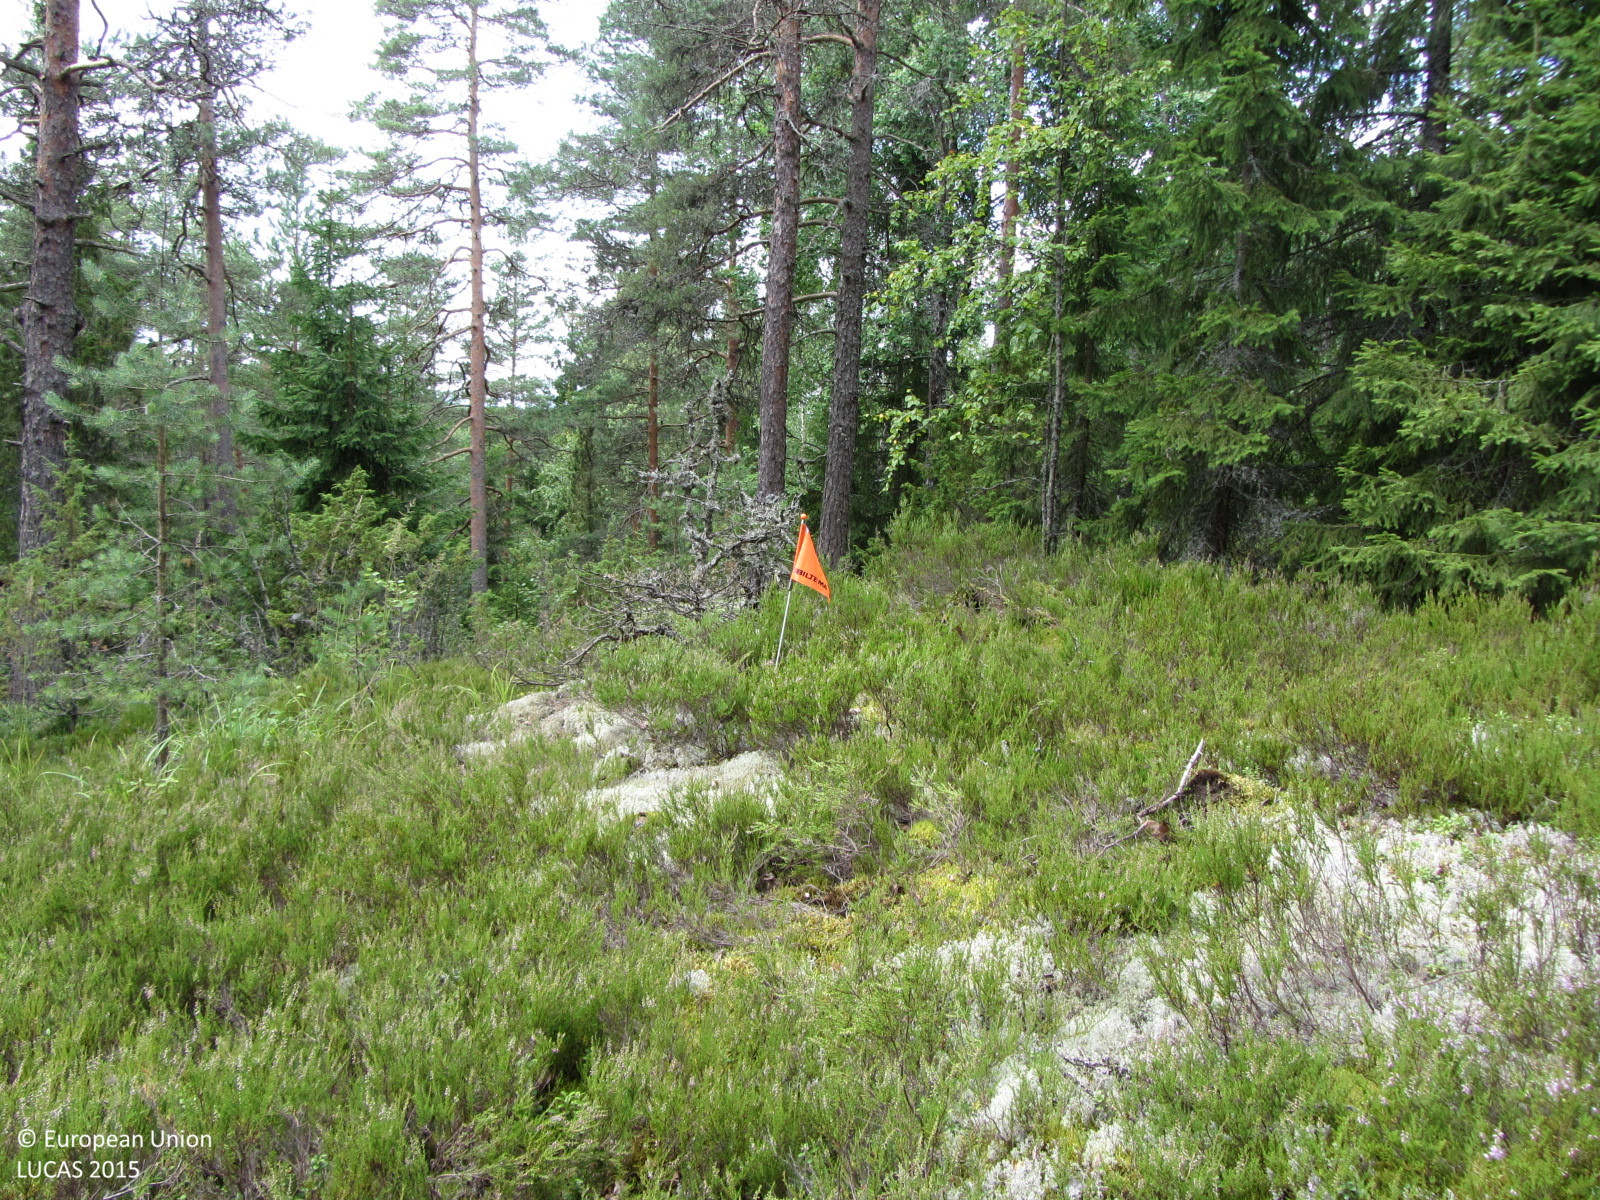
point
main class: Woodland
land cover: Other coniferous woodland
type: boreal forest
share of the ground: 50 - 75 %
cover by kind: coniferous forest trees 45 %, shrubs 25 %, lichens and mosses 20 %, broadleaved forest trees 5 %, herbaceous plants 5 %
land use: Forestry
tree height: > 5 m
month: July
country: FI
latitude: 60.4760
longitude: 24.4592
